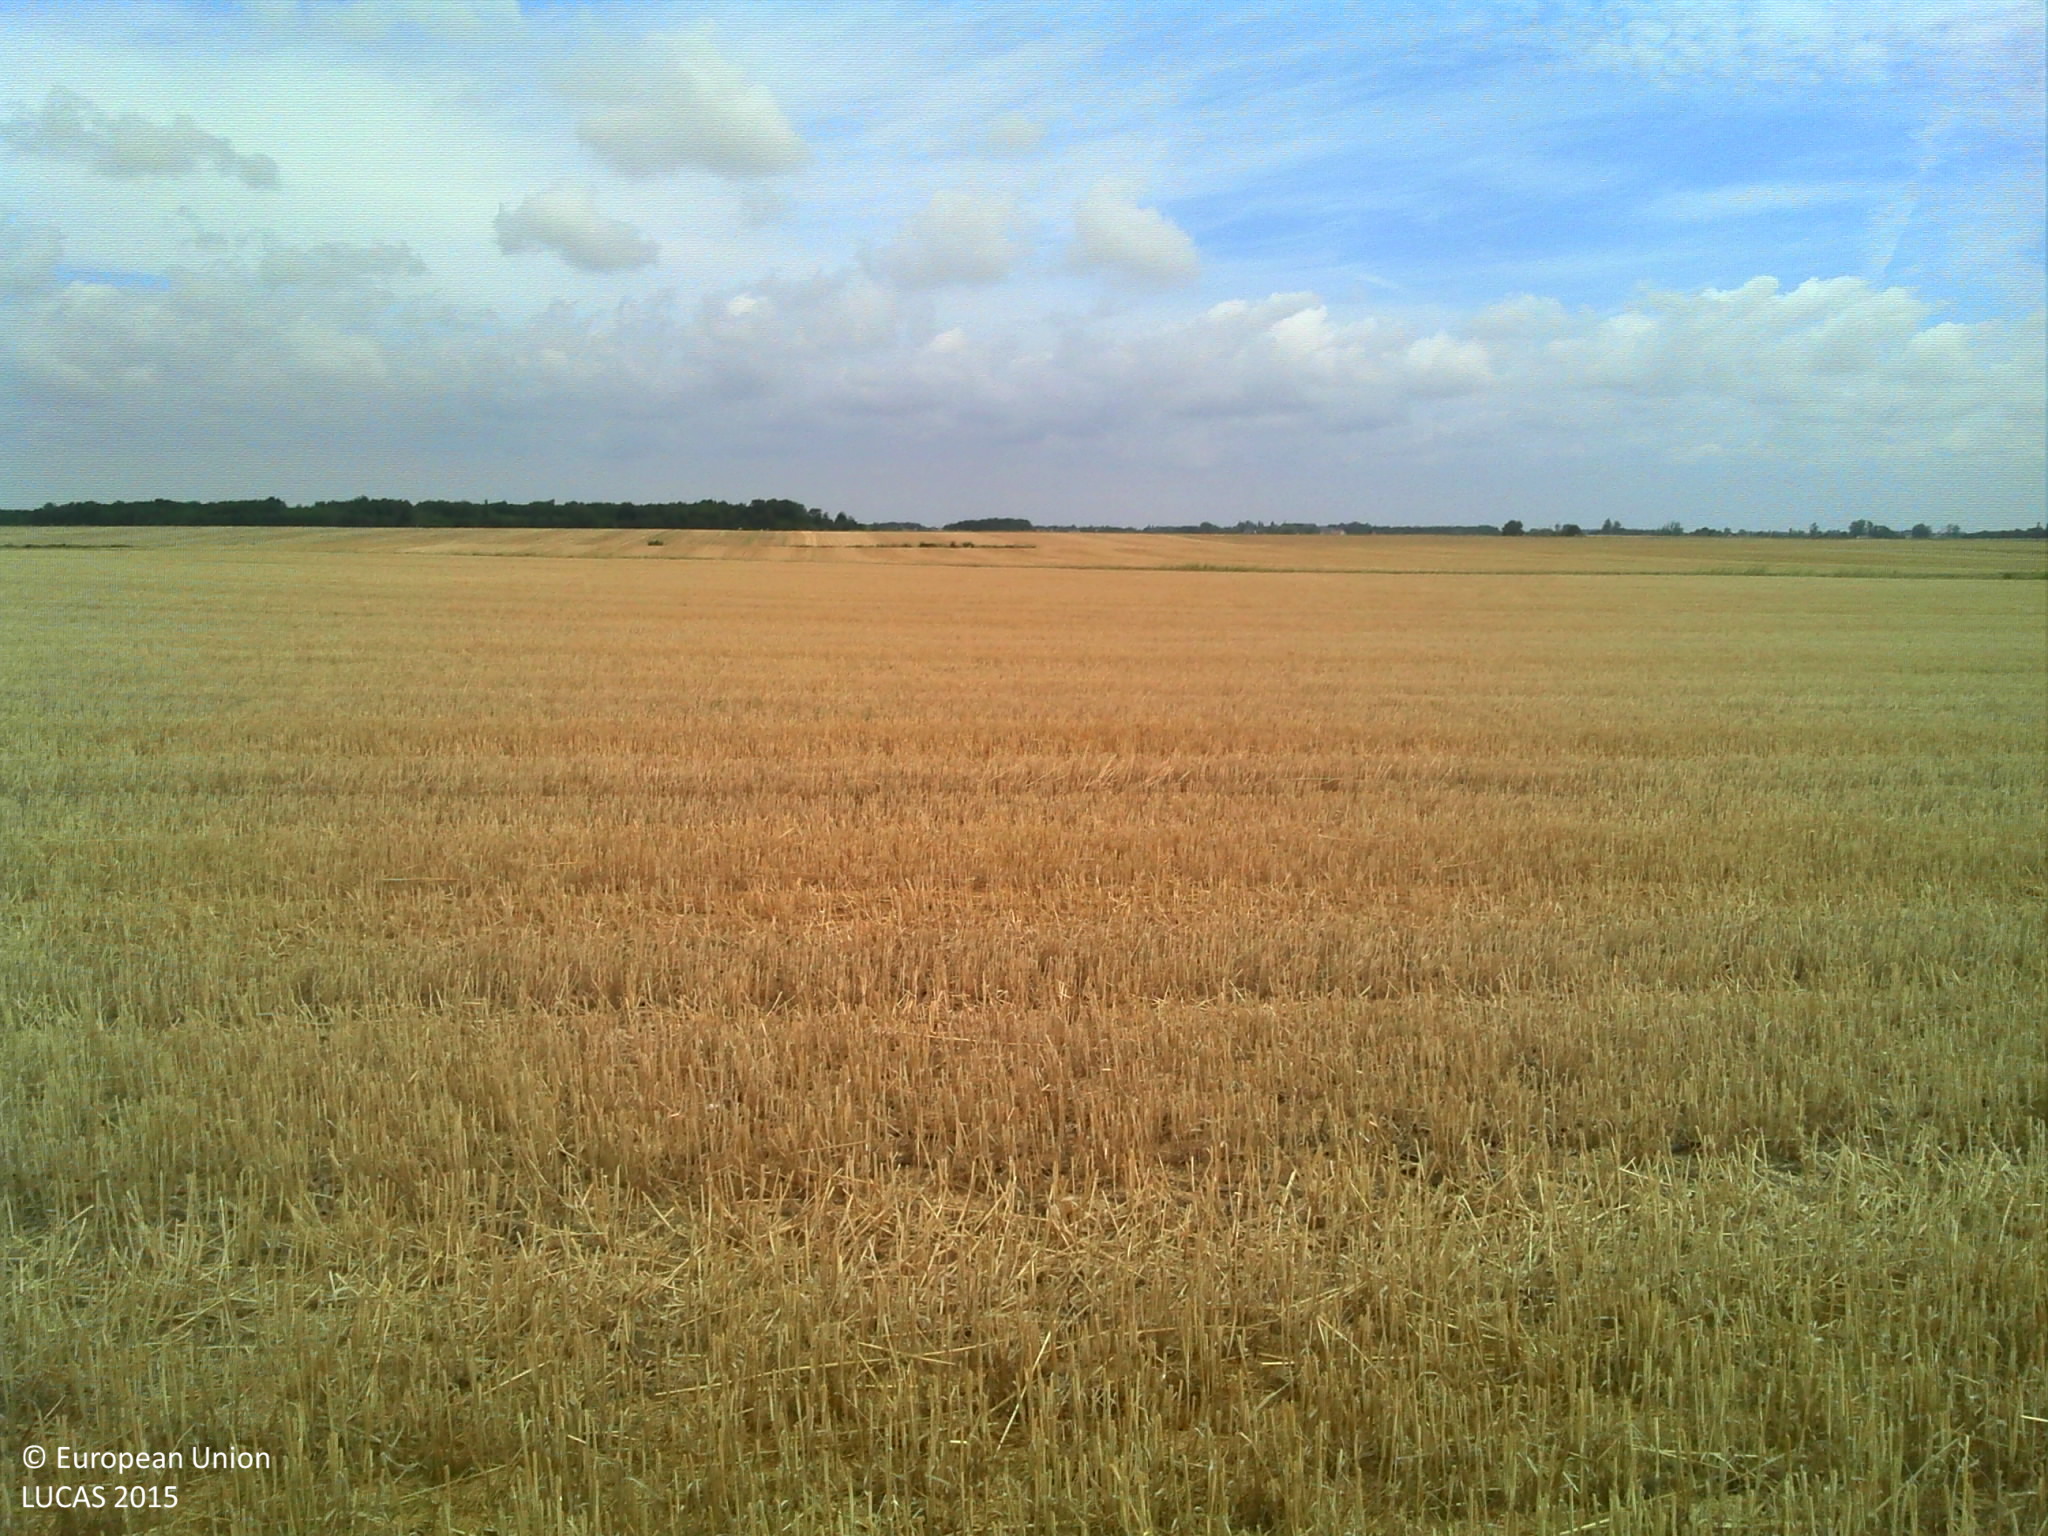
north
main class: Cropland
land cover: Common wheat
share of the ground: > 75 %
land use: Agriculture (excluding fallow land and kitchen gardens)
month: July
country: FR
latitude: 47.1535
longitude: 0.8428
